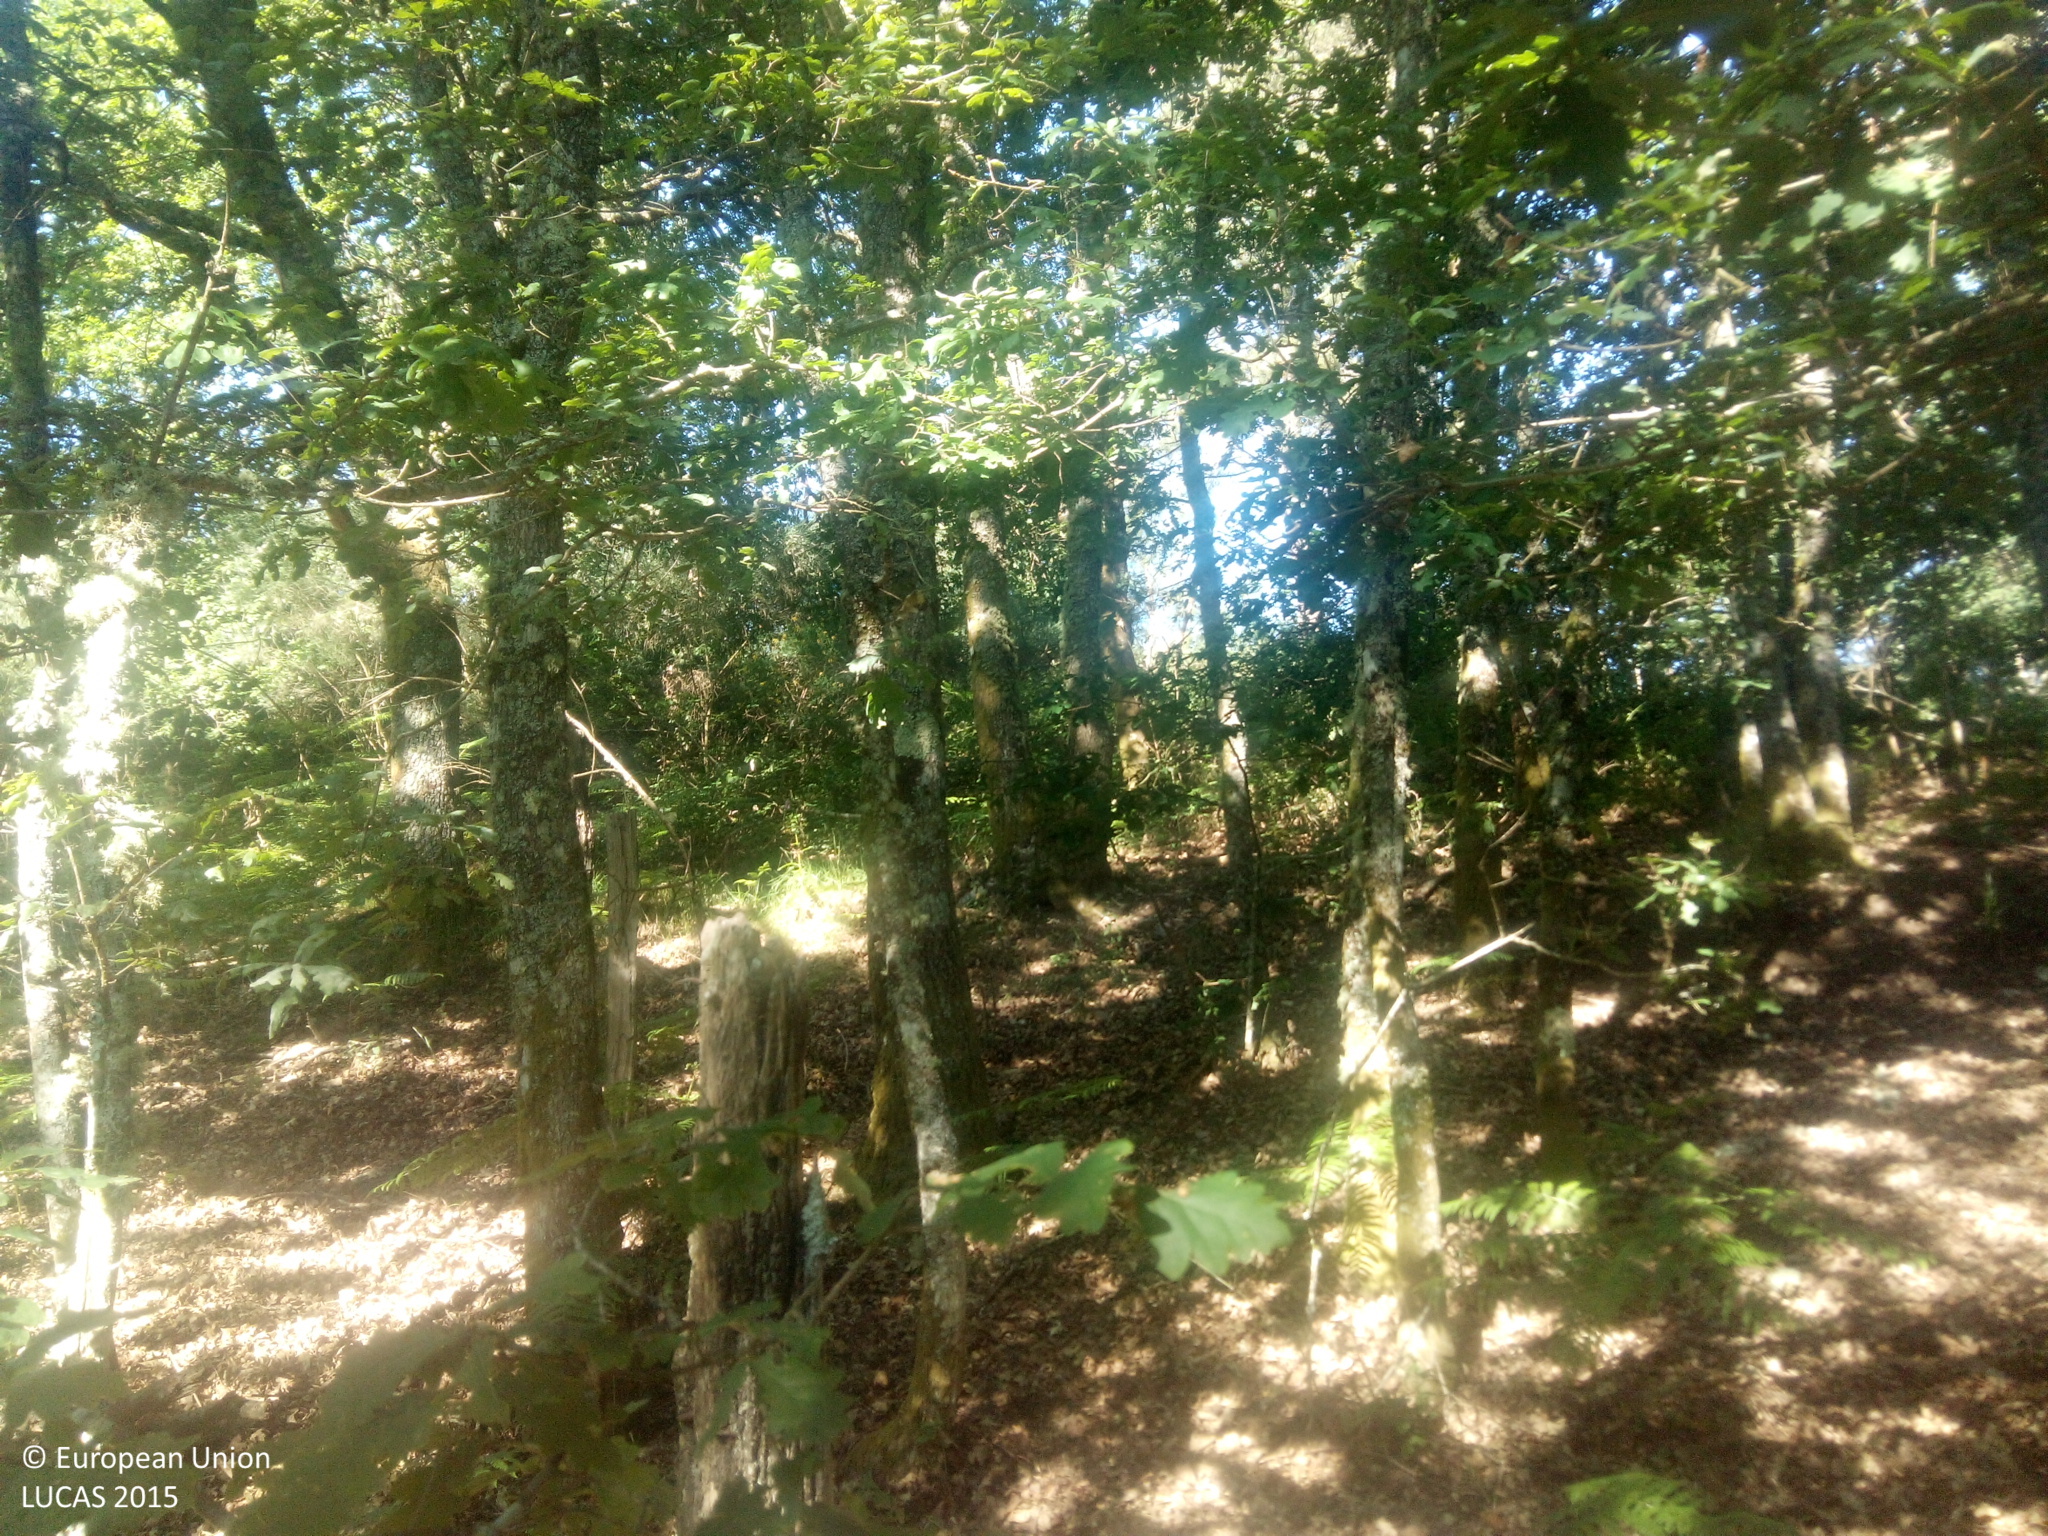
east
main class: Woodland
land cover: Broadleaved woodland
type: acidophilous oak and oak-birch forest
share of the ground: > 75 %
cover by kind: broadleaved forest trees 100 %
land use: Forestry
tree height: > 5 m
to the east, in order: Broadleaved woodland; Paved roads, cycling and walking lanes; Broadleaved woodland; Tracks; Broadleaved woodland
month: June
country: ES
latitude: 42.4313
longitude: -8.2871
